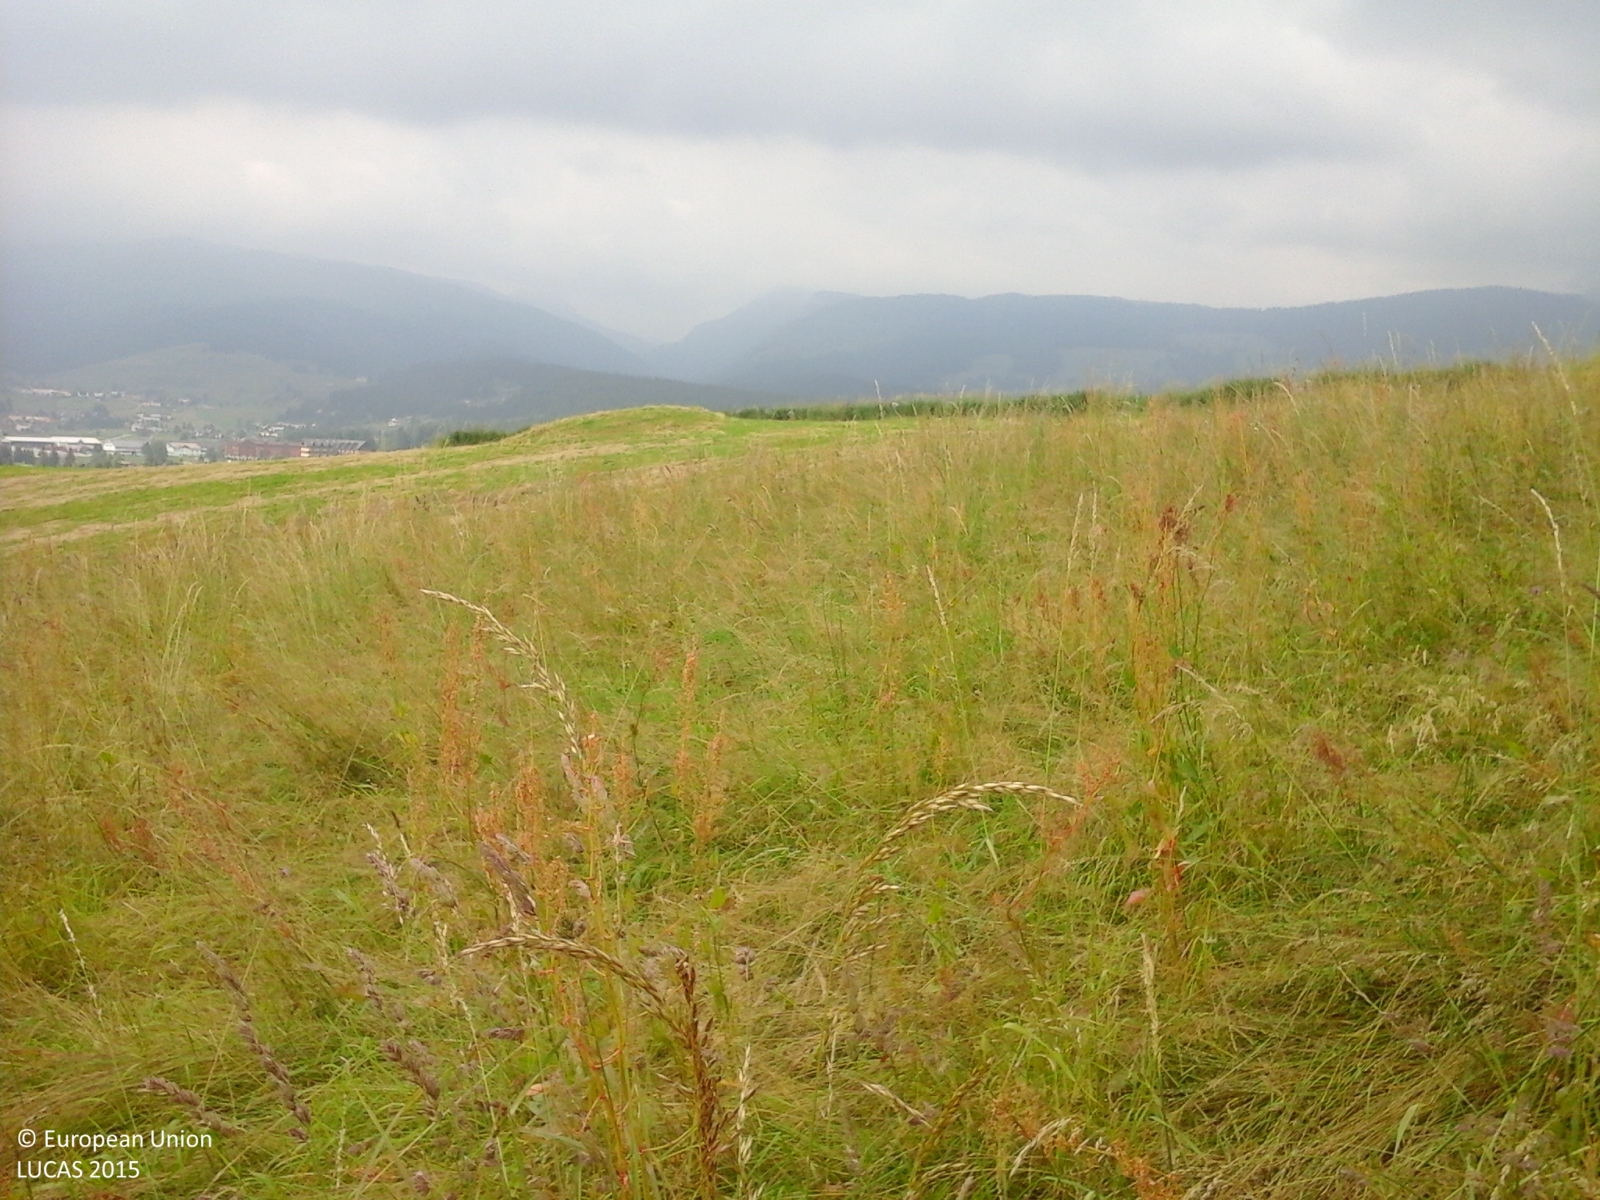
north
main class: Grassland
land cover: Grassland without tree/shrub cover
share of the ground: > 75 %
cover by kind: herbaceous plants 100 %
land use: Agriculture (excluding fallow land and kitchen gardens)
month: June
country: IT
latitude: 45.8718
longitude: 11.5308
